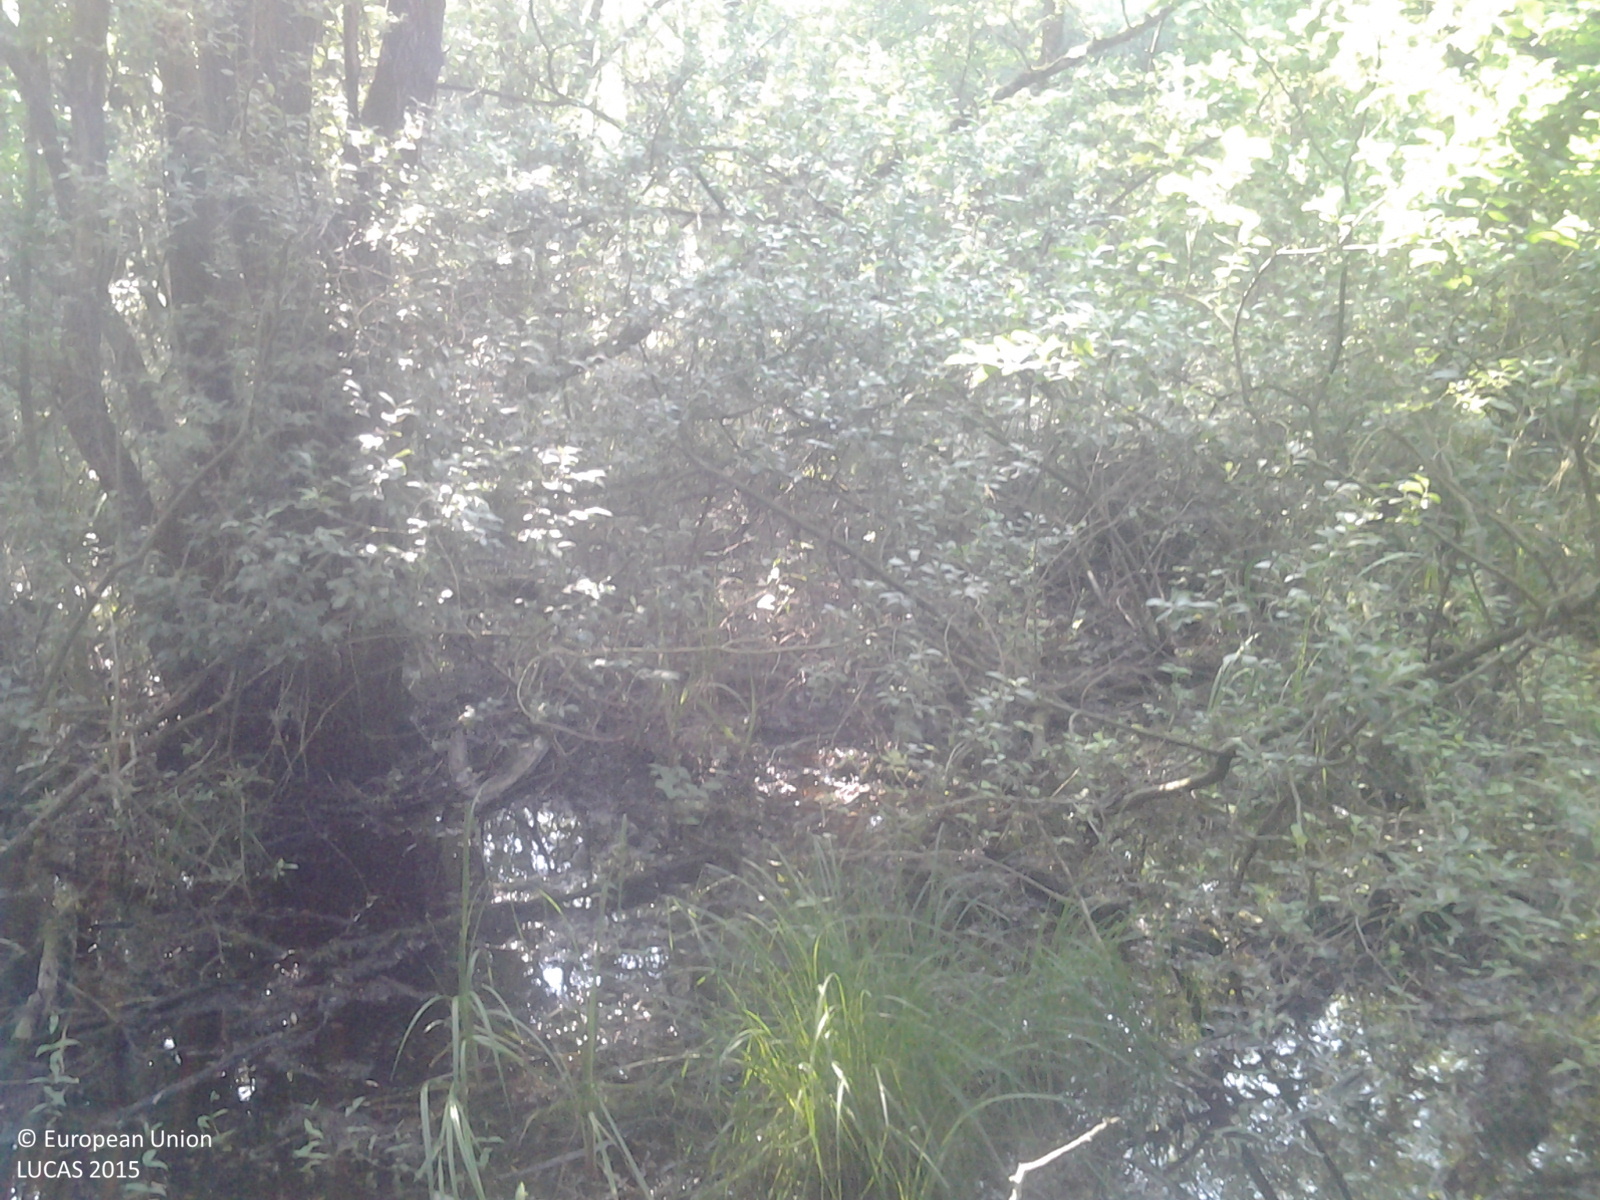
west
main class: Woodland
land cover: Broadleaved woodland
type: mesophytic deciduous forest
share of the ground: > 75 %
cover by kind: broadleaved forest trees 95 %, shrubs 5 %
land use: Forestry
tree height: > 5 m
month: June
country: HU
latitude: 46.6069
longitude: 19.1937
